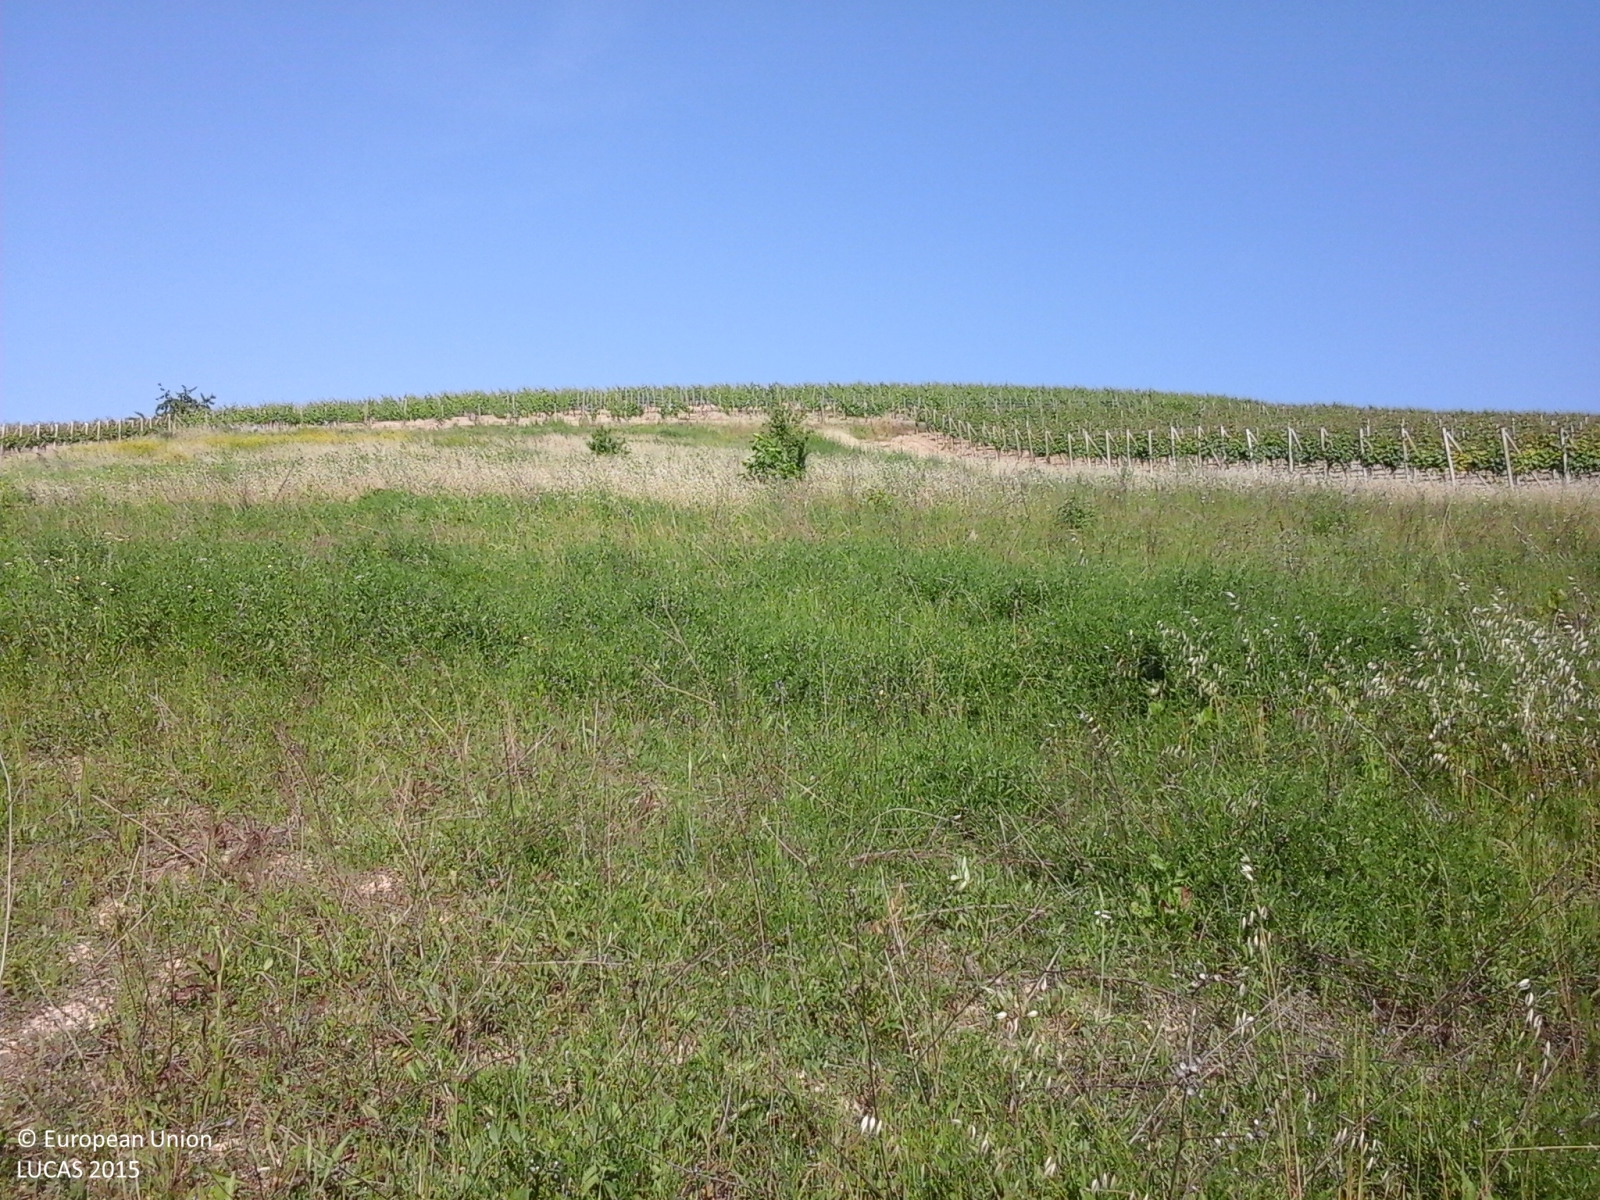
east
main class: Grassland
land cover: Spontaneously vegetated surfaces
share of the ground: > 75 %
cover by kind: herbaceous plants 100 %
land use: Fallow land
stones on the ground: < 10 %
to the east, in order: Spontaneously vegetated surfaces; Vineyards; Grass margins; Ditches and canals; Tracks; Ditches and canals; Grass margins; Vineyards; Tracks; Other bare soil
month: May
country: IT
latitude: 44.7015
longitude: 8.5768
